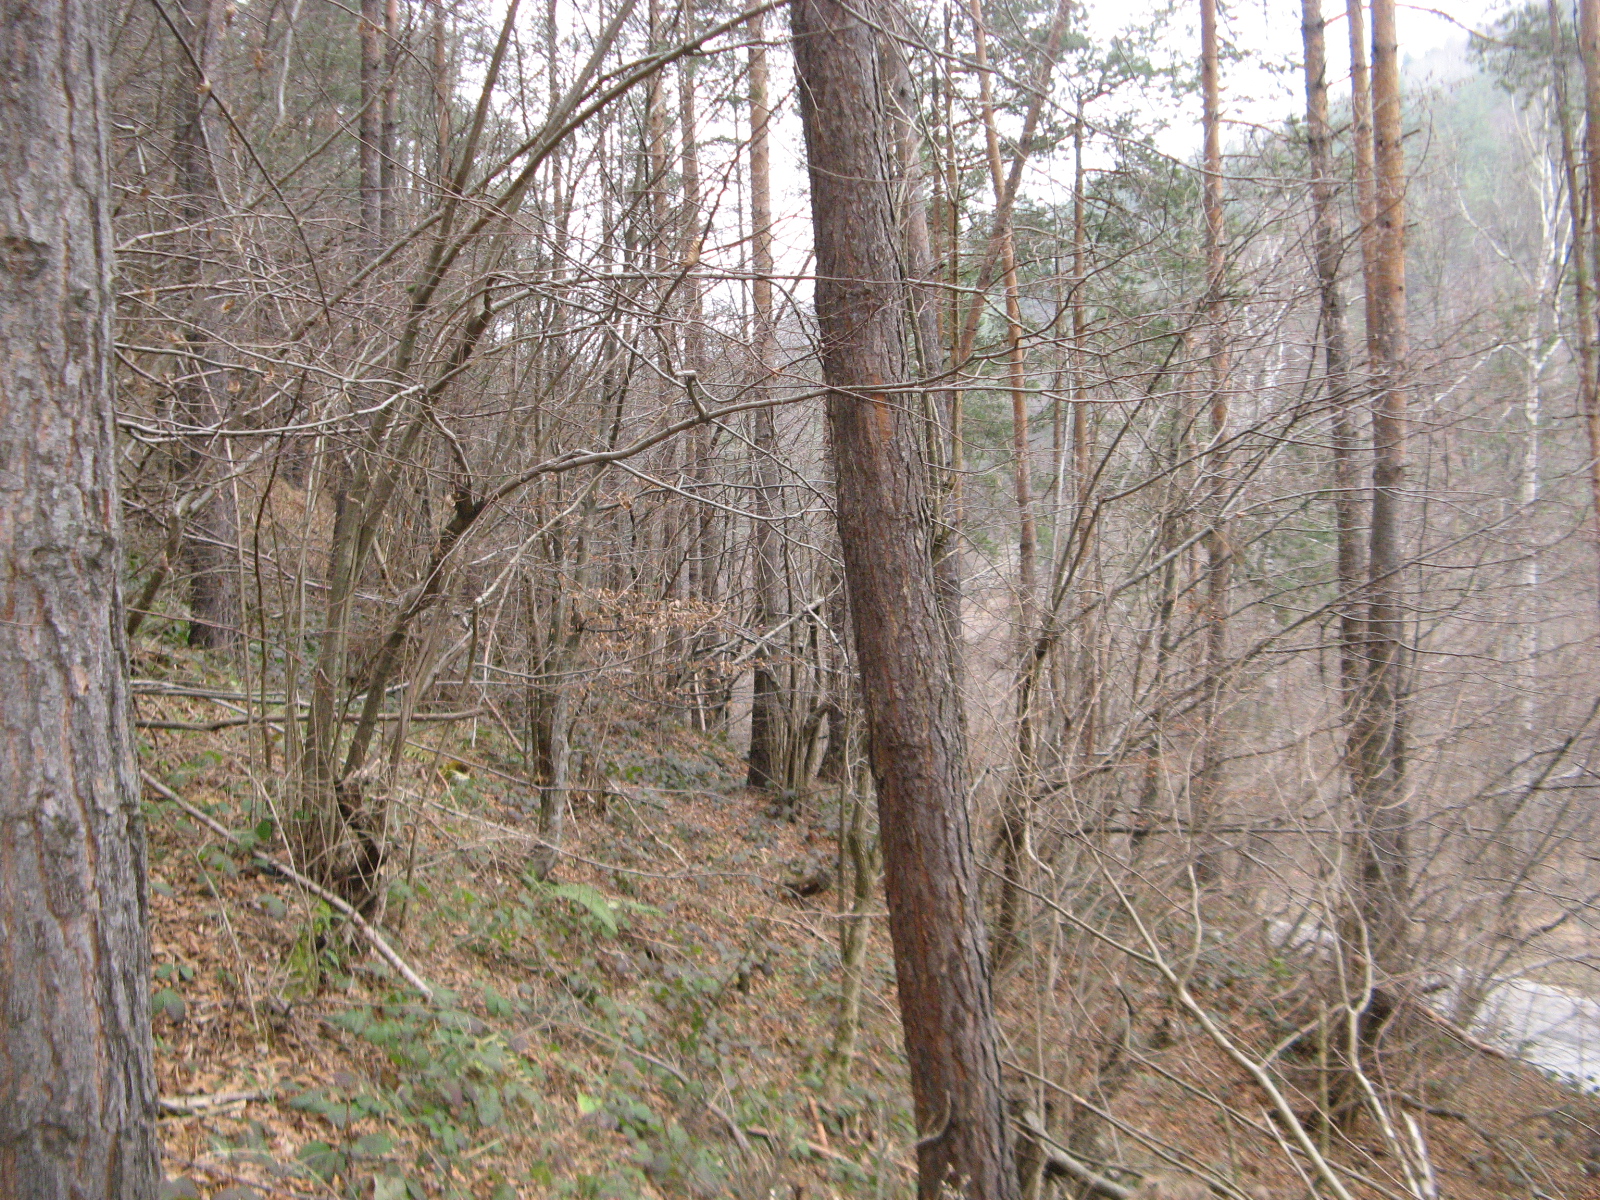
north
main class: Woodland
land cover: Pine dominated mixed woodland
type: hemiboreal forest and nemoral coniferous forest and mixed broadleaved-coniferous forest
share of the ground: > 75 %
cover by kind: coniferous forest trees 60 %, broadleaved forest trees 30 %, herbaceous plants 5 %, unconsolidated bare surface 5 %
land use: Forestry
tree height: > 5 m
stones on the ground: < 10 %
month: December
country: BG
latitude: 41.9534
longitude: 24.2398
